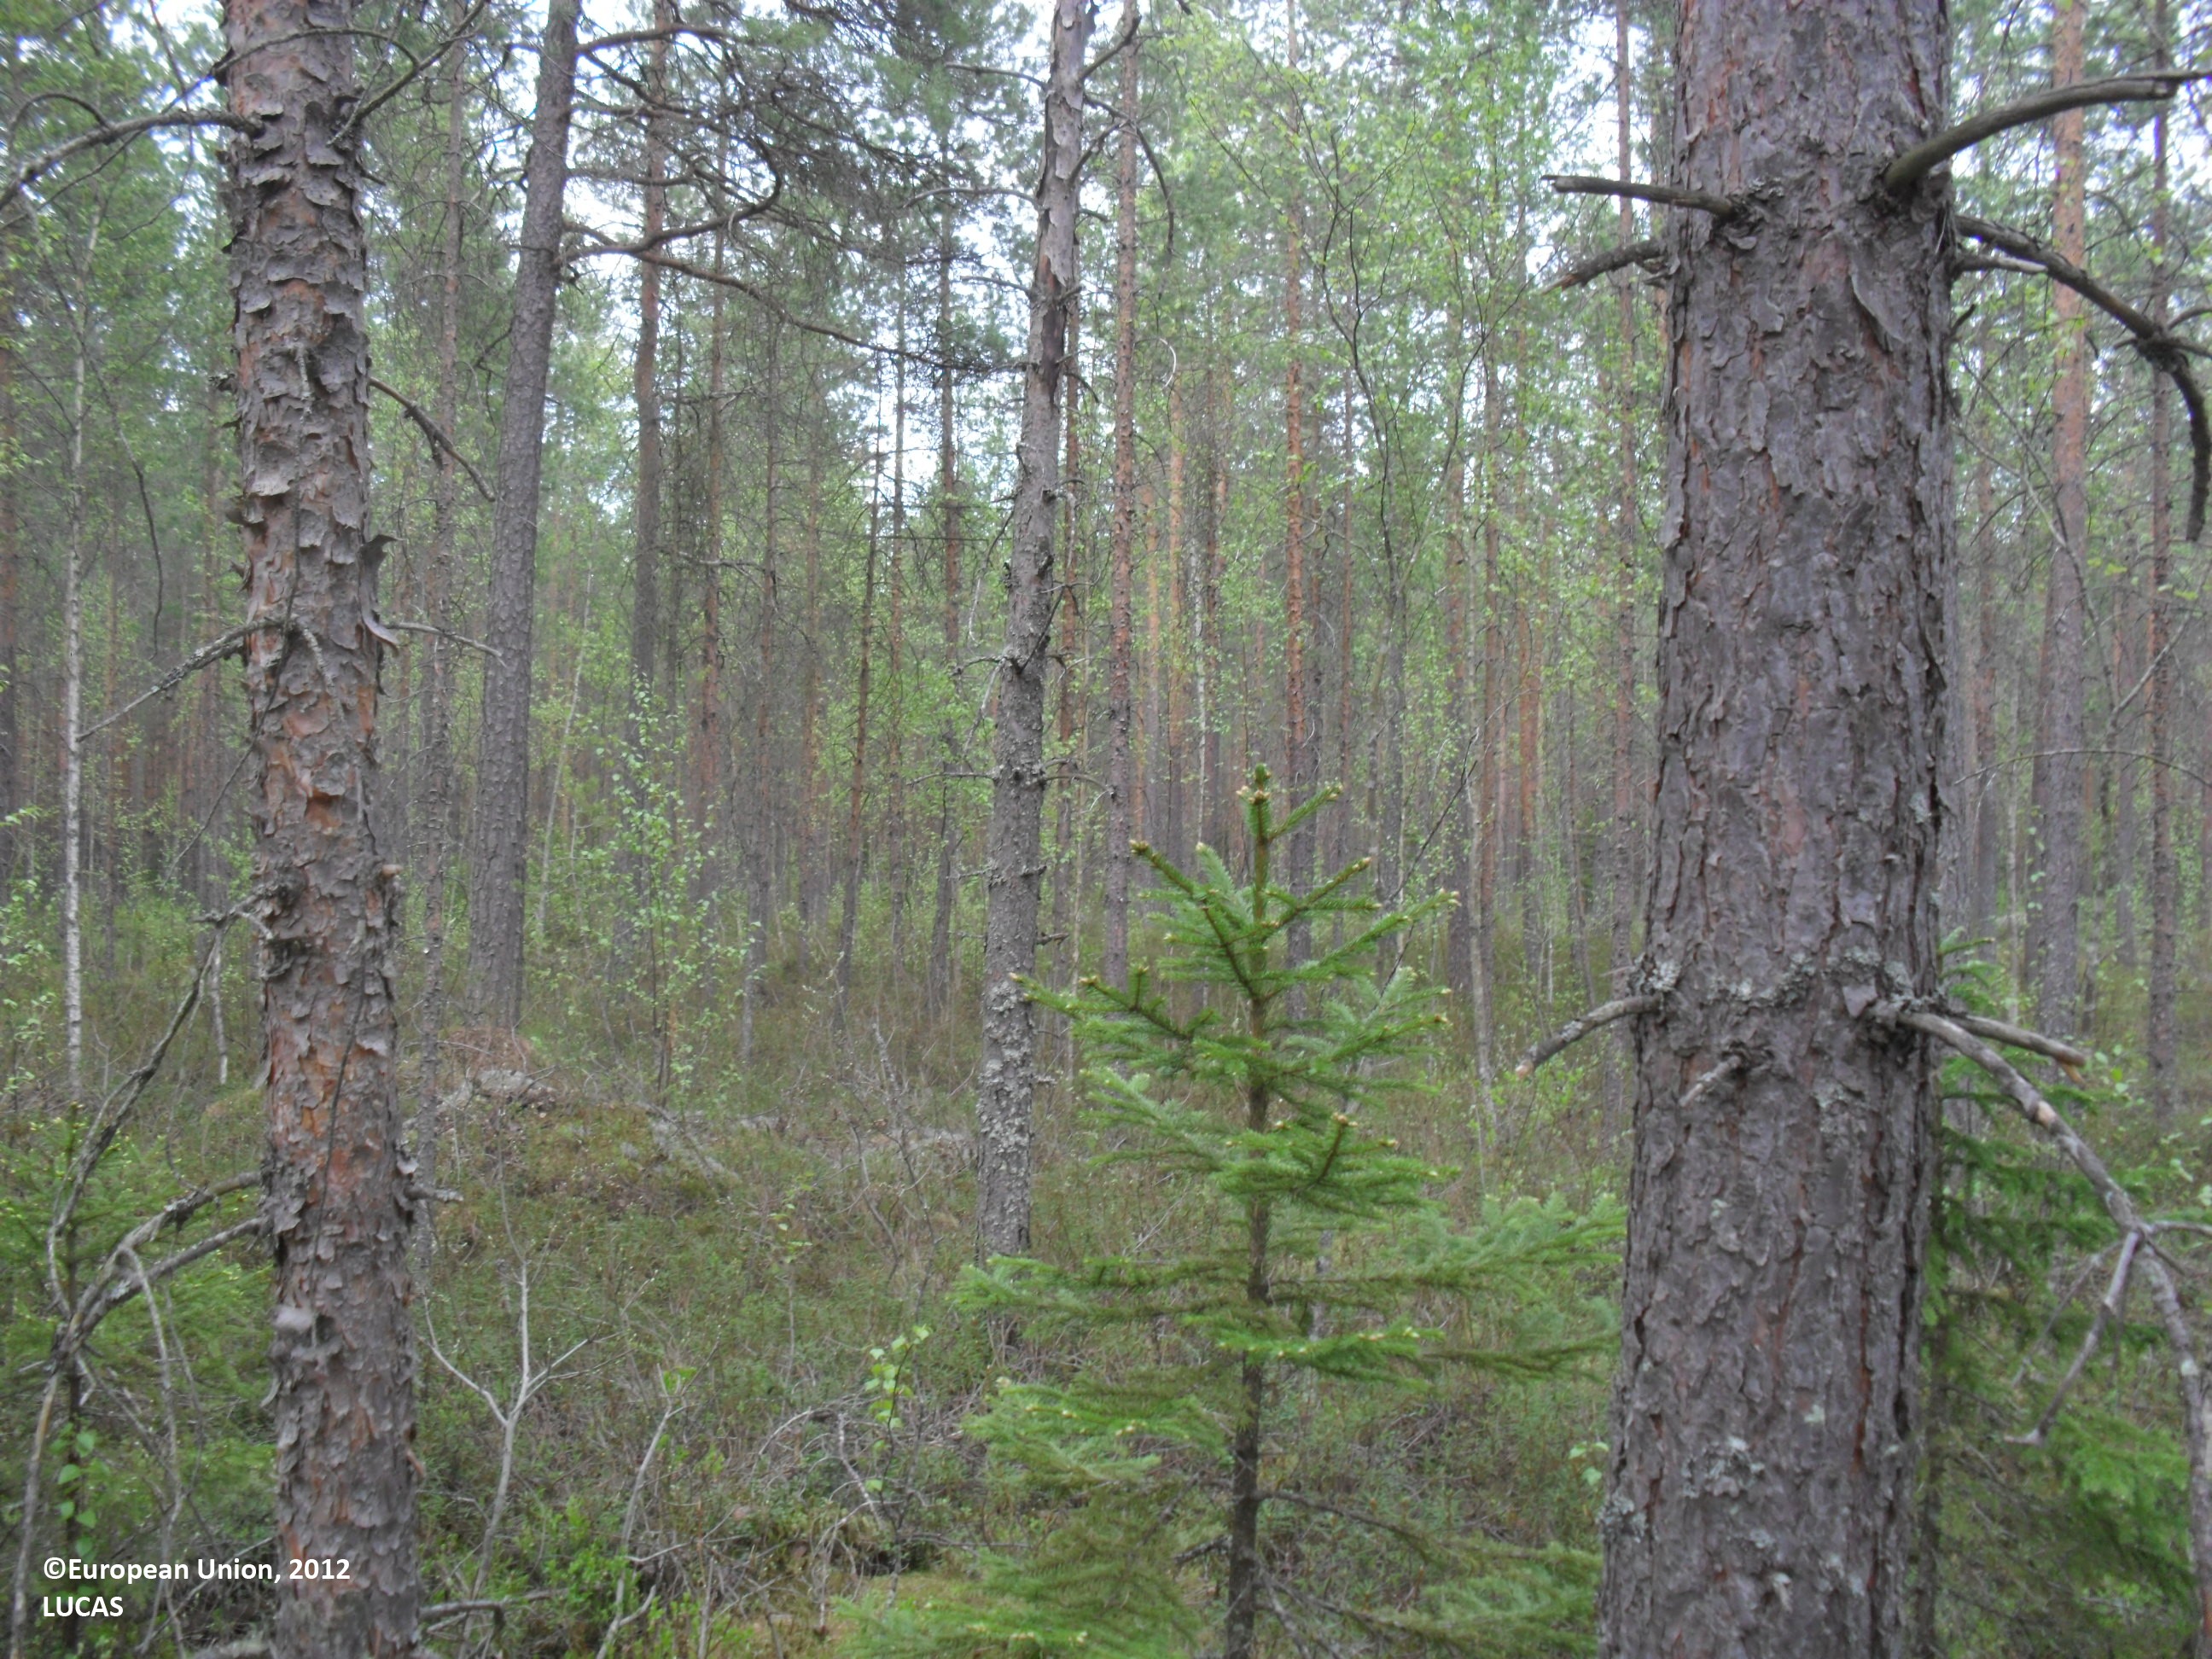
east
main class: Woodland
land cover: Pine dominated coniferous woodland
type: boreal forest
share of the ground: 50 - 75 %
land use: Forestry
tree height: > 5 m
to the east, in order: Pine dominated coniferous woodland; Tracks; Pine dominated coniferous woodland; Ditches and canals
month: May
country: FI
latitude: 63.2645
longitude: 23.1082
